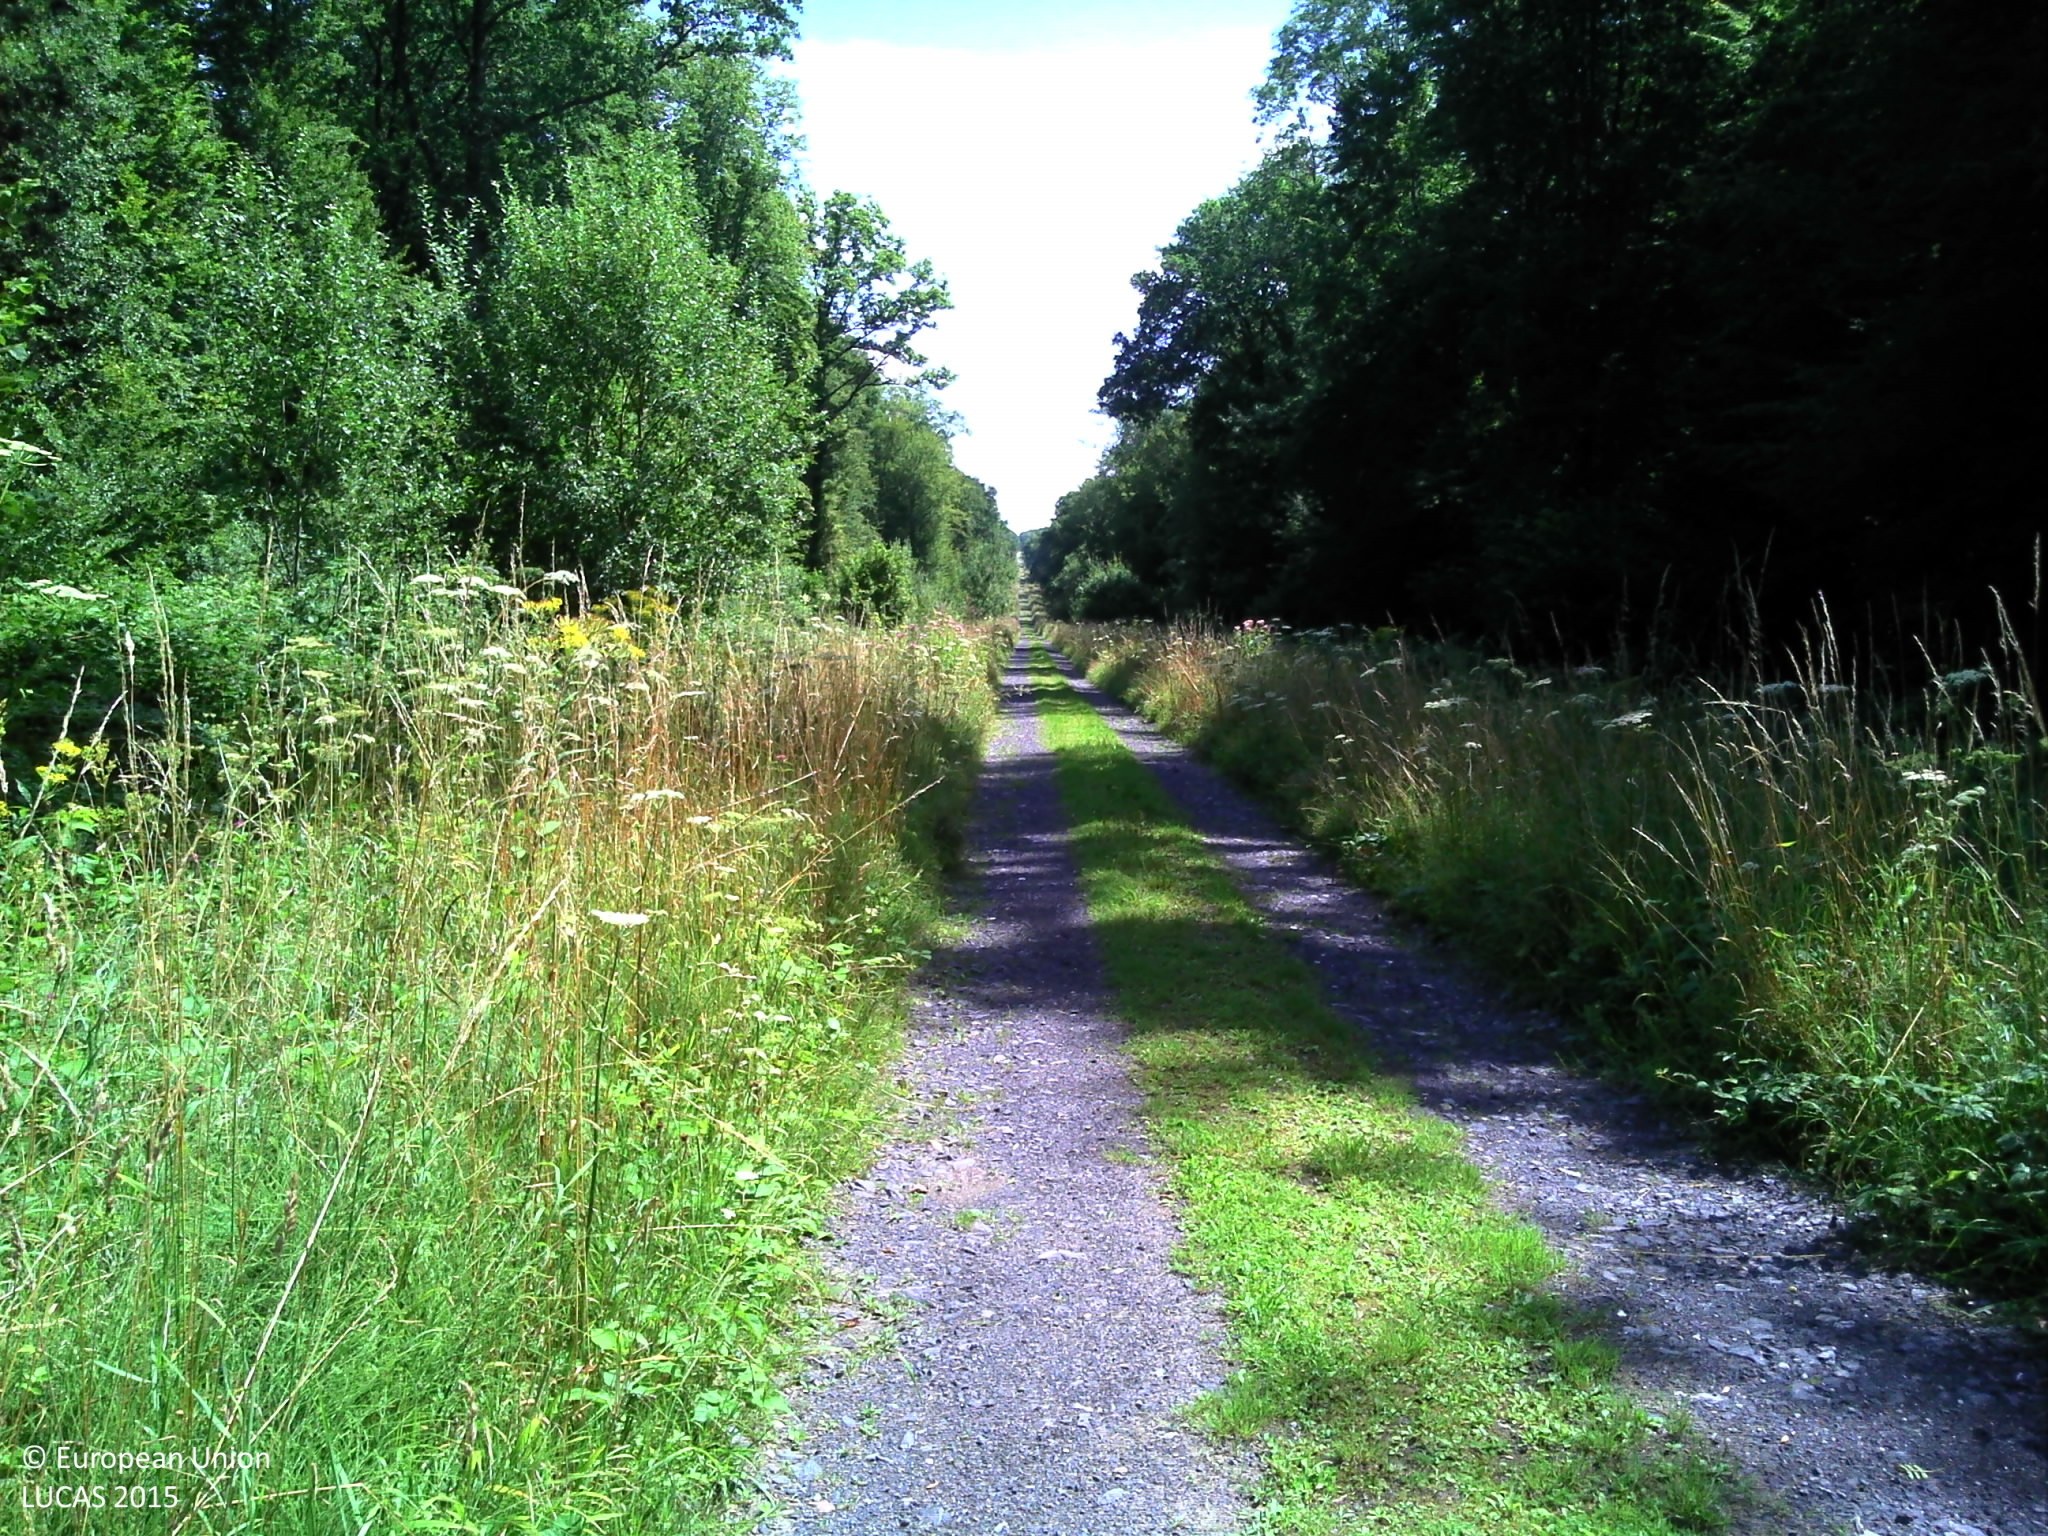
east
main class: Woodland
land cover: Broadleaved woodland
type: mesophytic deciduous forest
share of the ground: > 75 %
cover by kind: broadleaved forest trees 85 %, herbaceous plants 10 %, lichens and mosses 5 %
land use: Forestry
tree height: > 5 m
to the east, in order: Broadleaved woodland
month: August
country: FR
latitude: 49.9922
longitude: 4.0384
